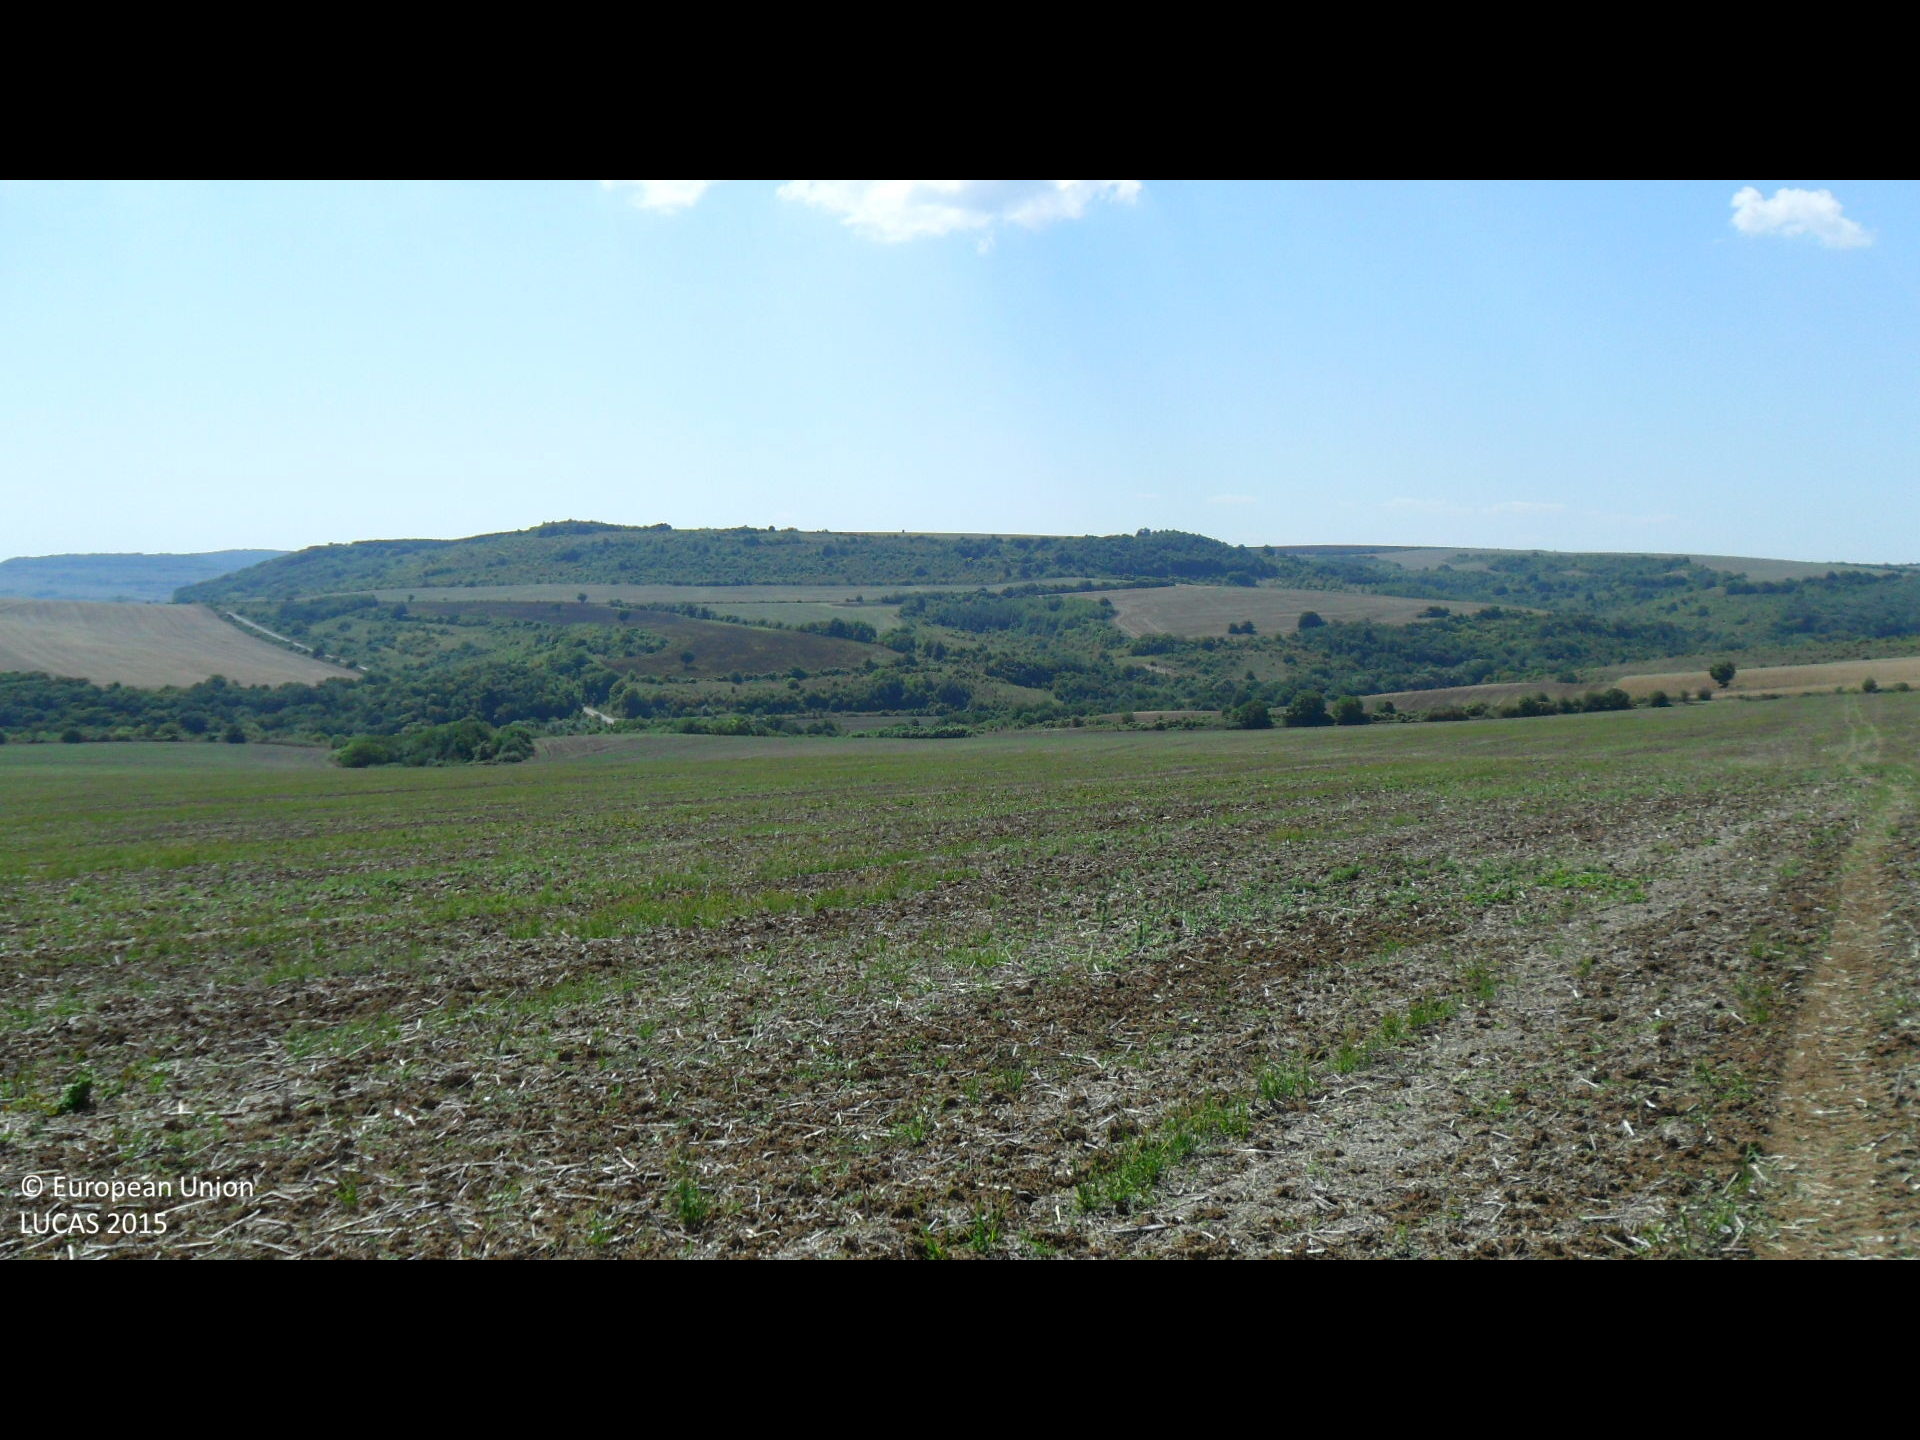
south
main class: Cropland
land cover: Rape and turnip rape
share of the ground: < 10 %
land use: Agriculture (excluding fallow land and kitchen gardens)
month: August
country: BG
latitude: 43.5021
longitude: 26.2384
